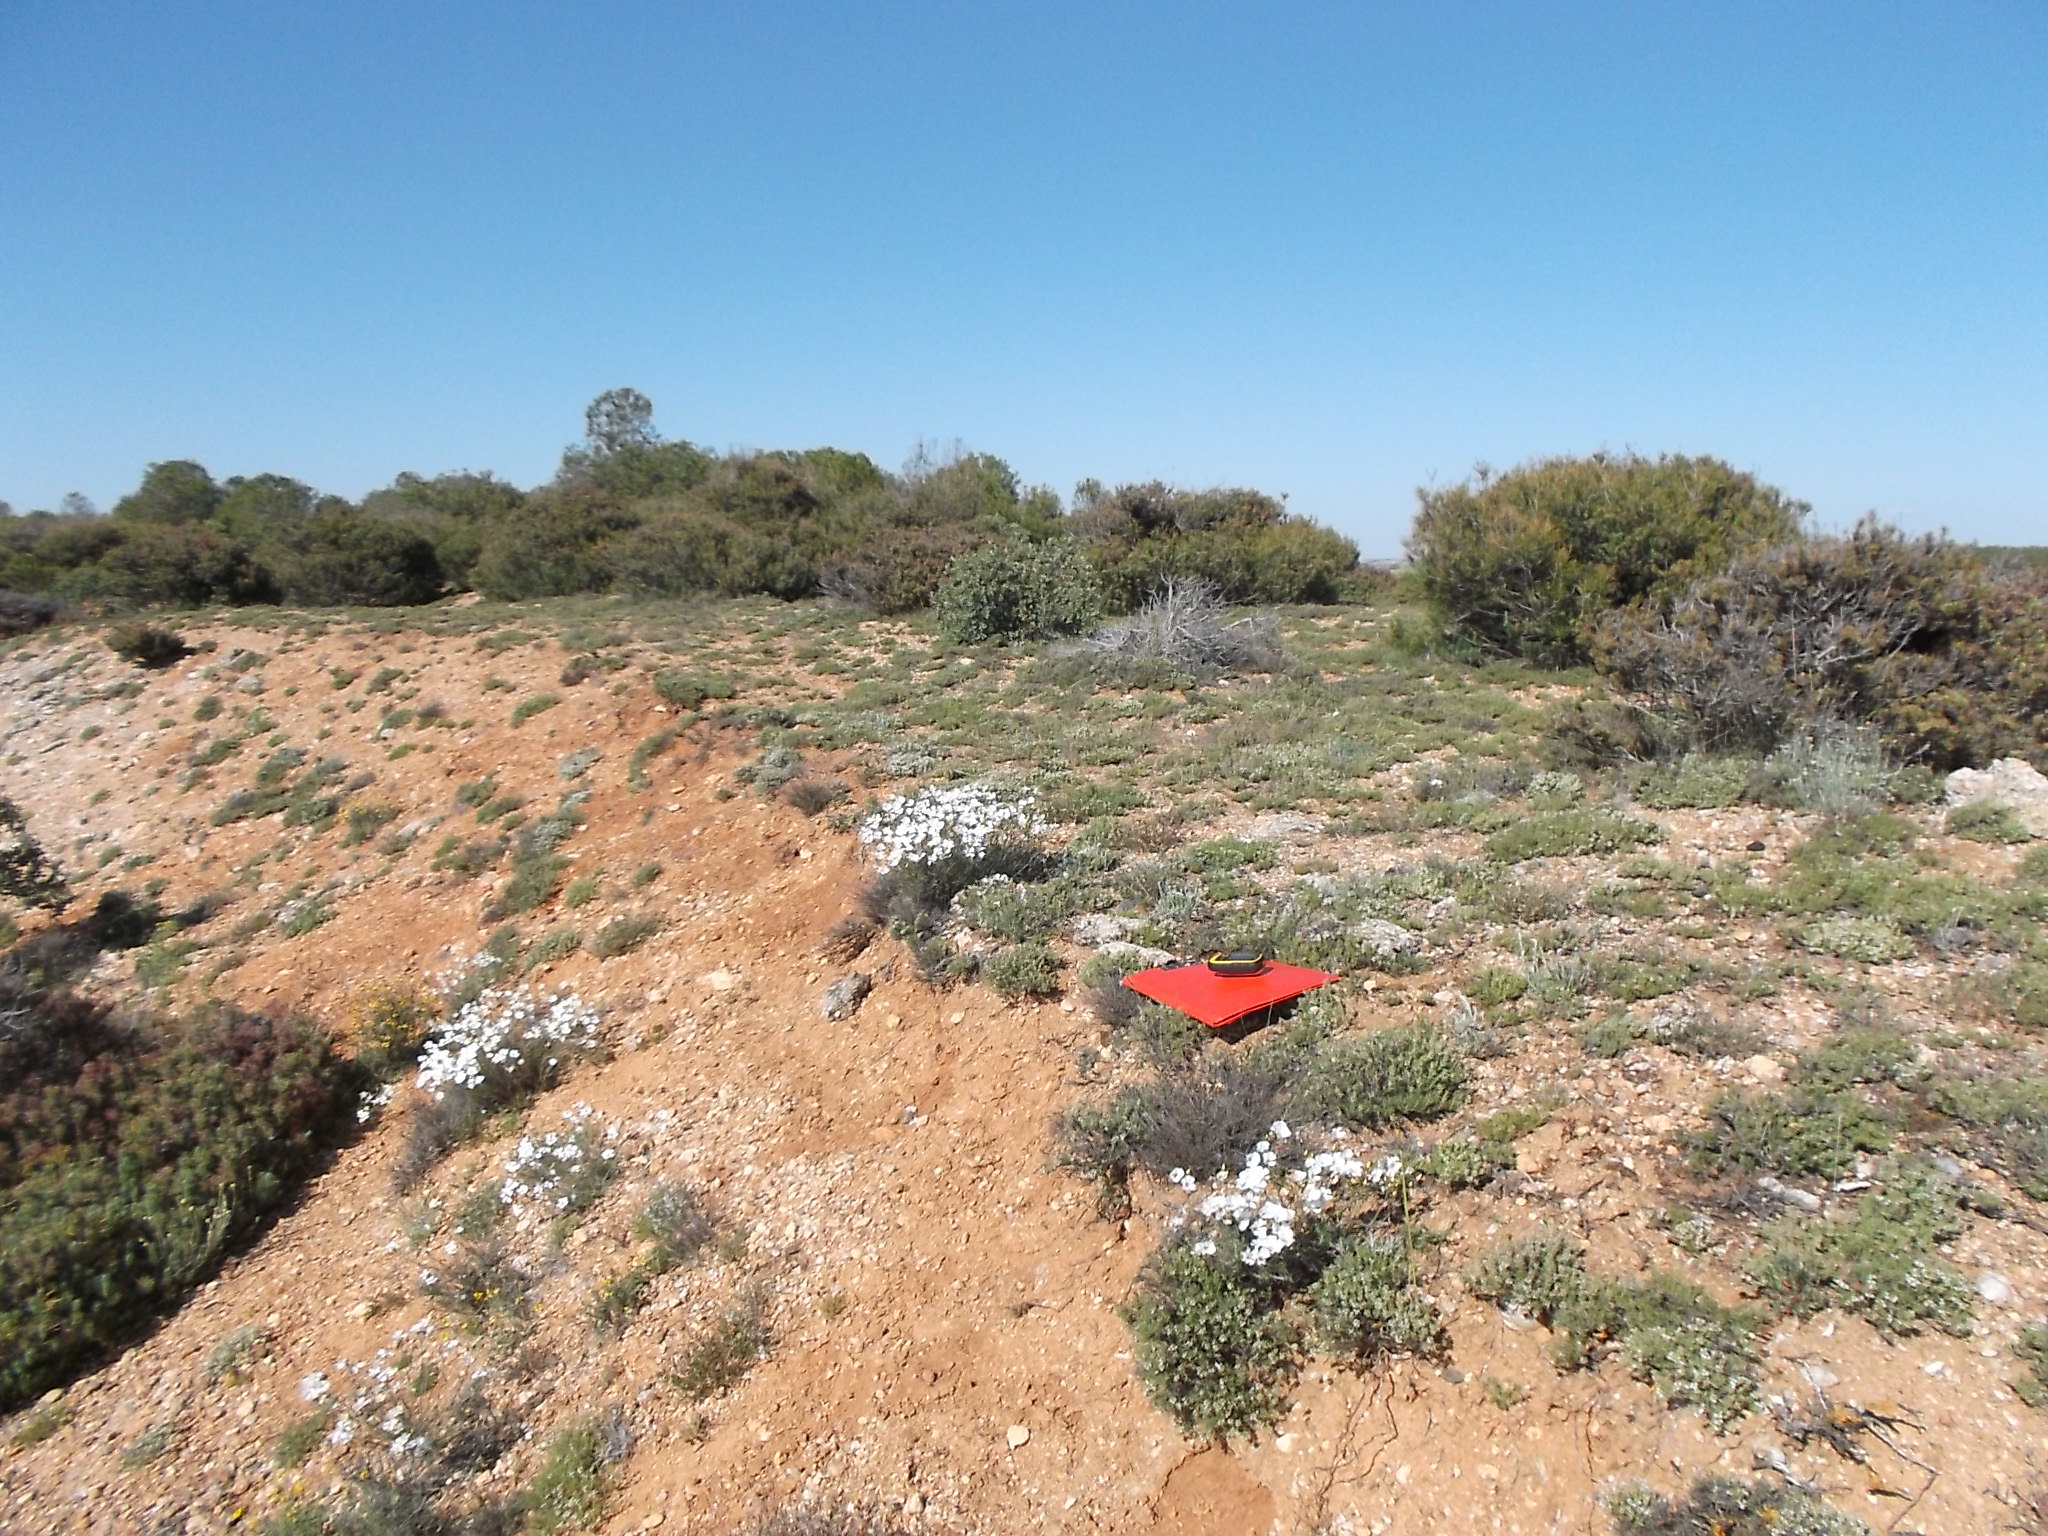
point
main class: Woodland
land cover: Pine dominated mixed woodland
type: coniferous forest of the mediterranean region
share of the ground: 25 - 50 %
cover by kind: herbaceous plants 35 %, coniferous forest trees 25 %, unconsolidated bare surface 20 %, broadleaved forest trees 10 %, shrubs 10 %
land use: Forestry
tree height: < 5 m
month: May
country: ES
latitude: 41.2109
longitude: -5.4013
